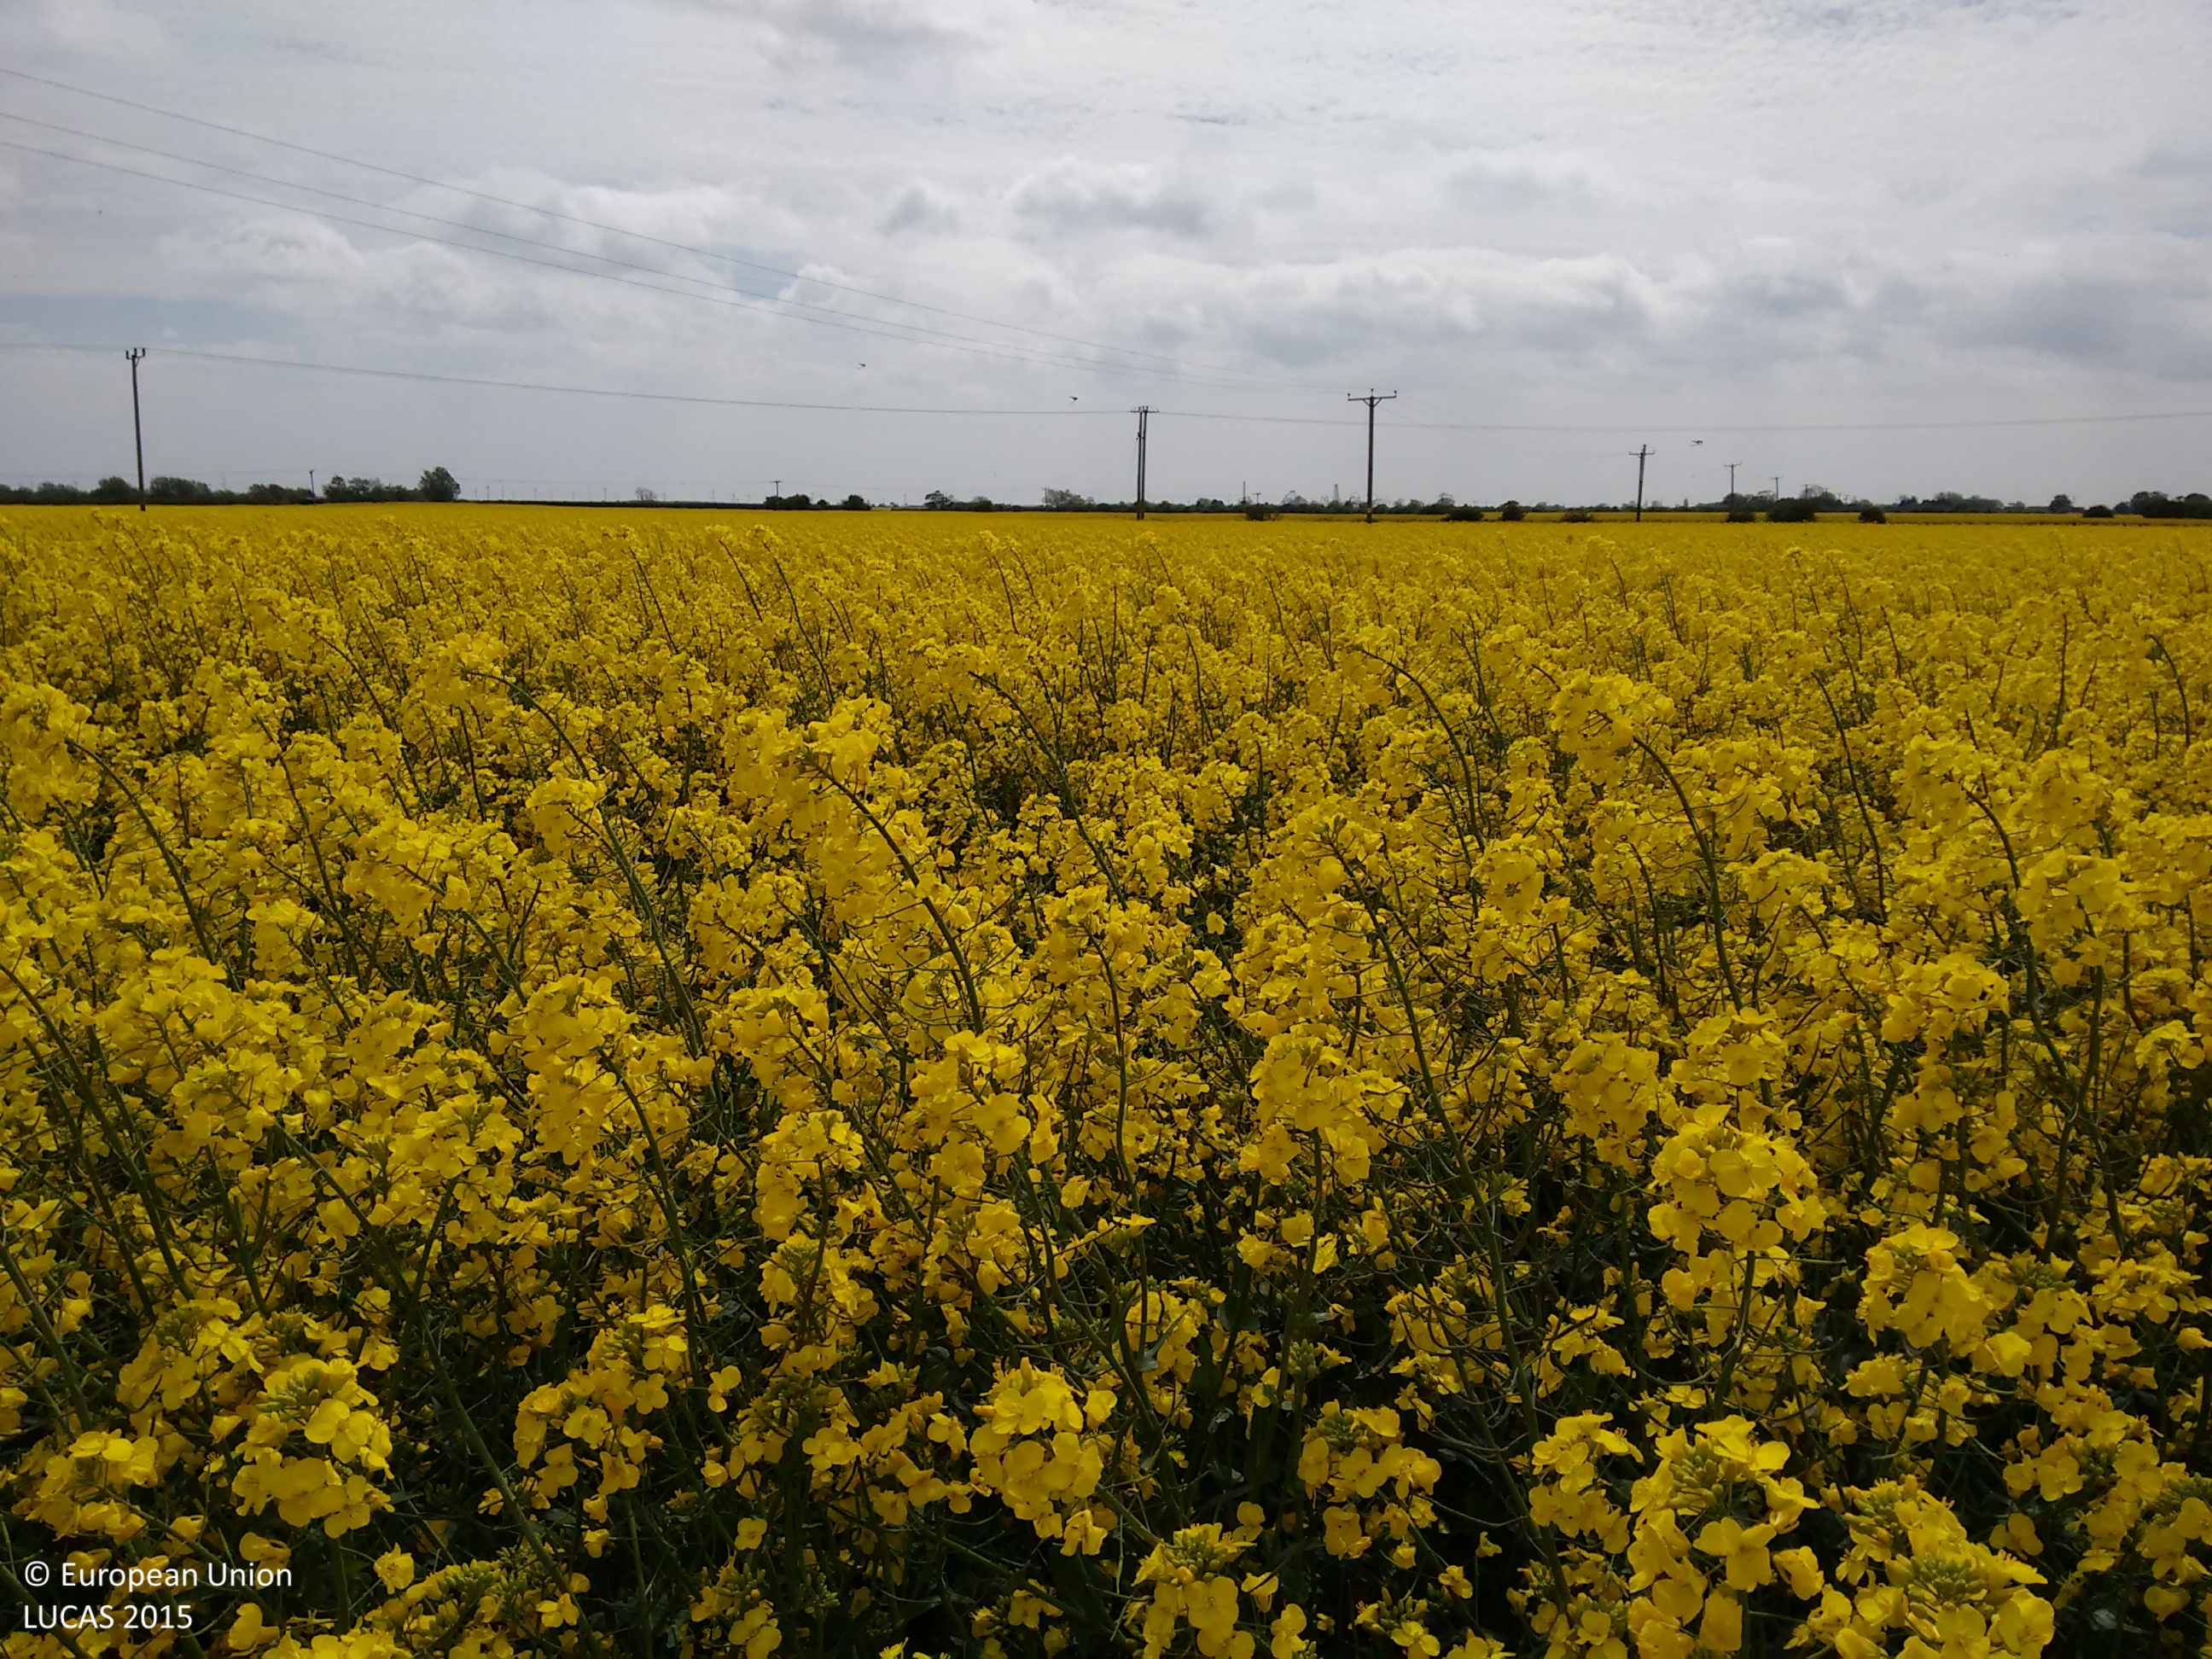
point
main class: Cropland
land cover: Rape and turnip rape
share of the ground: > 75 %
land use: Agriculture (excluding fallow land and kitchen gardens)
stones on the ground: < 10 %
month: May
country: GB
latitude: 53.2120
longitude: 0.3129
